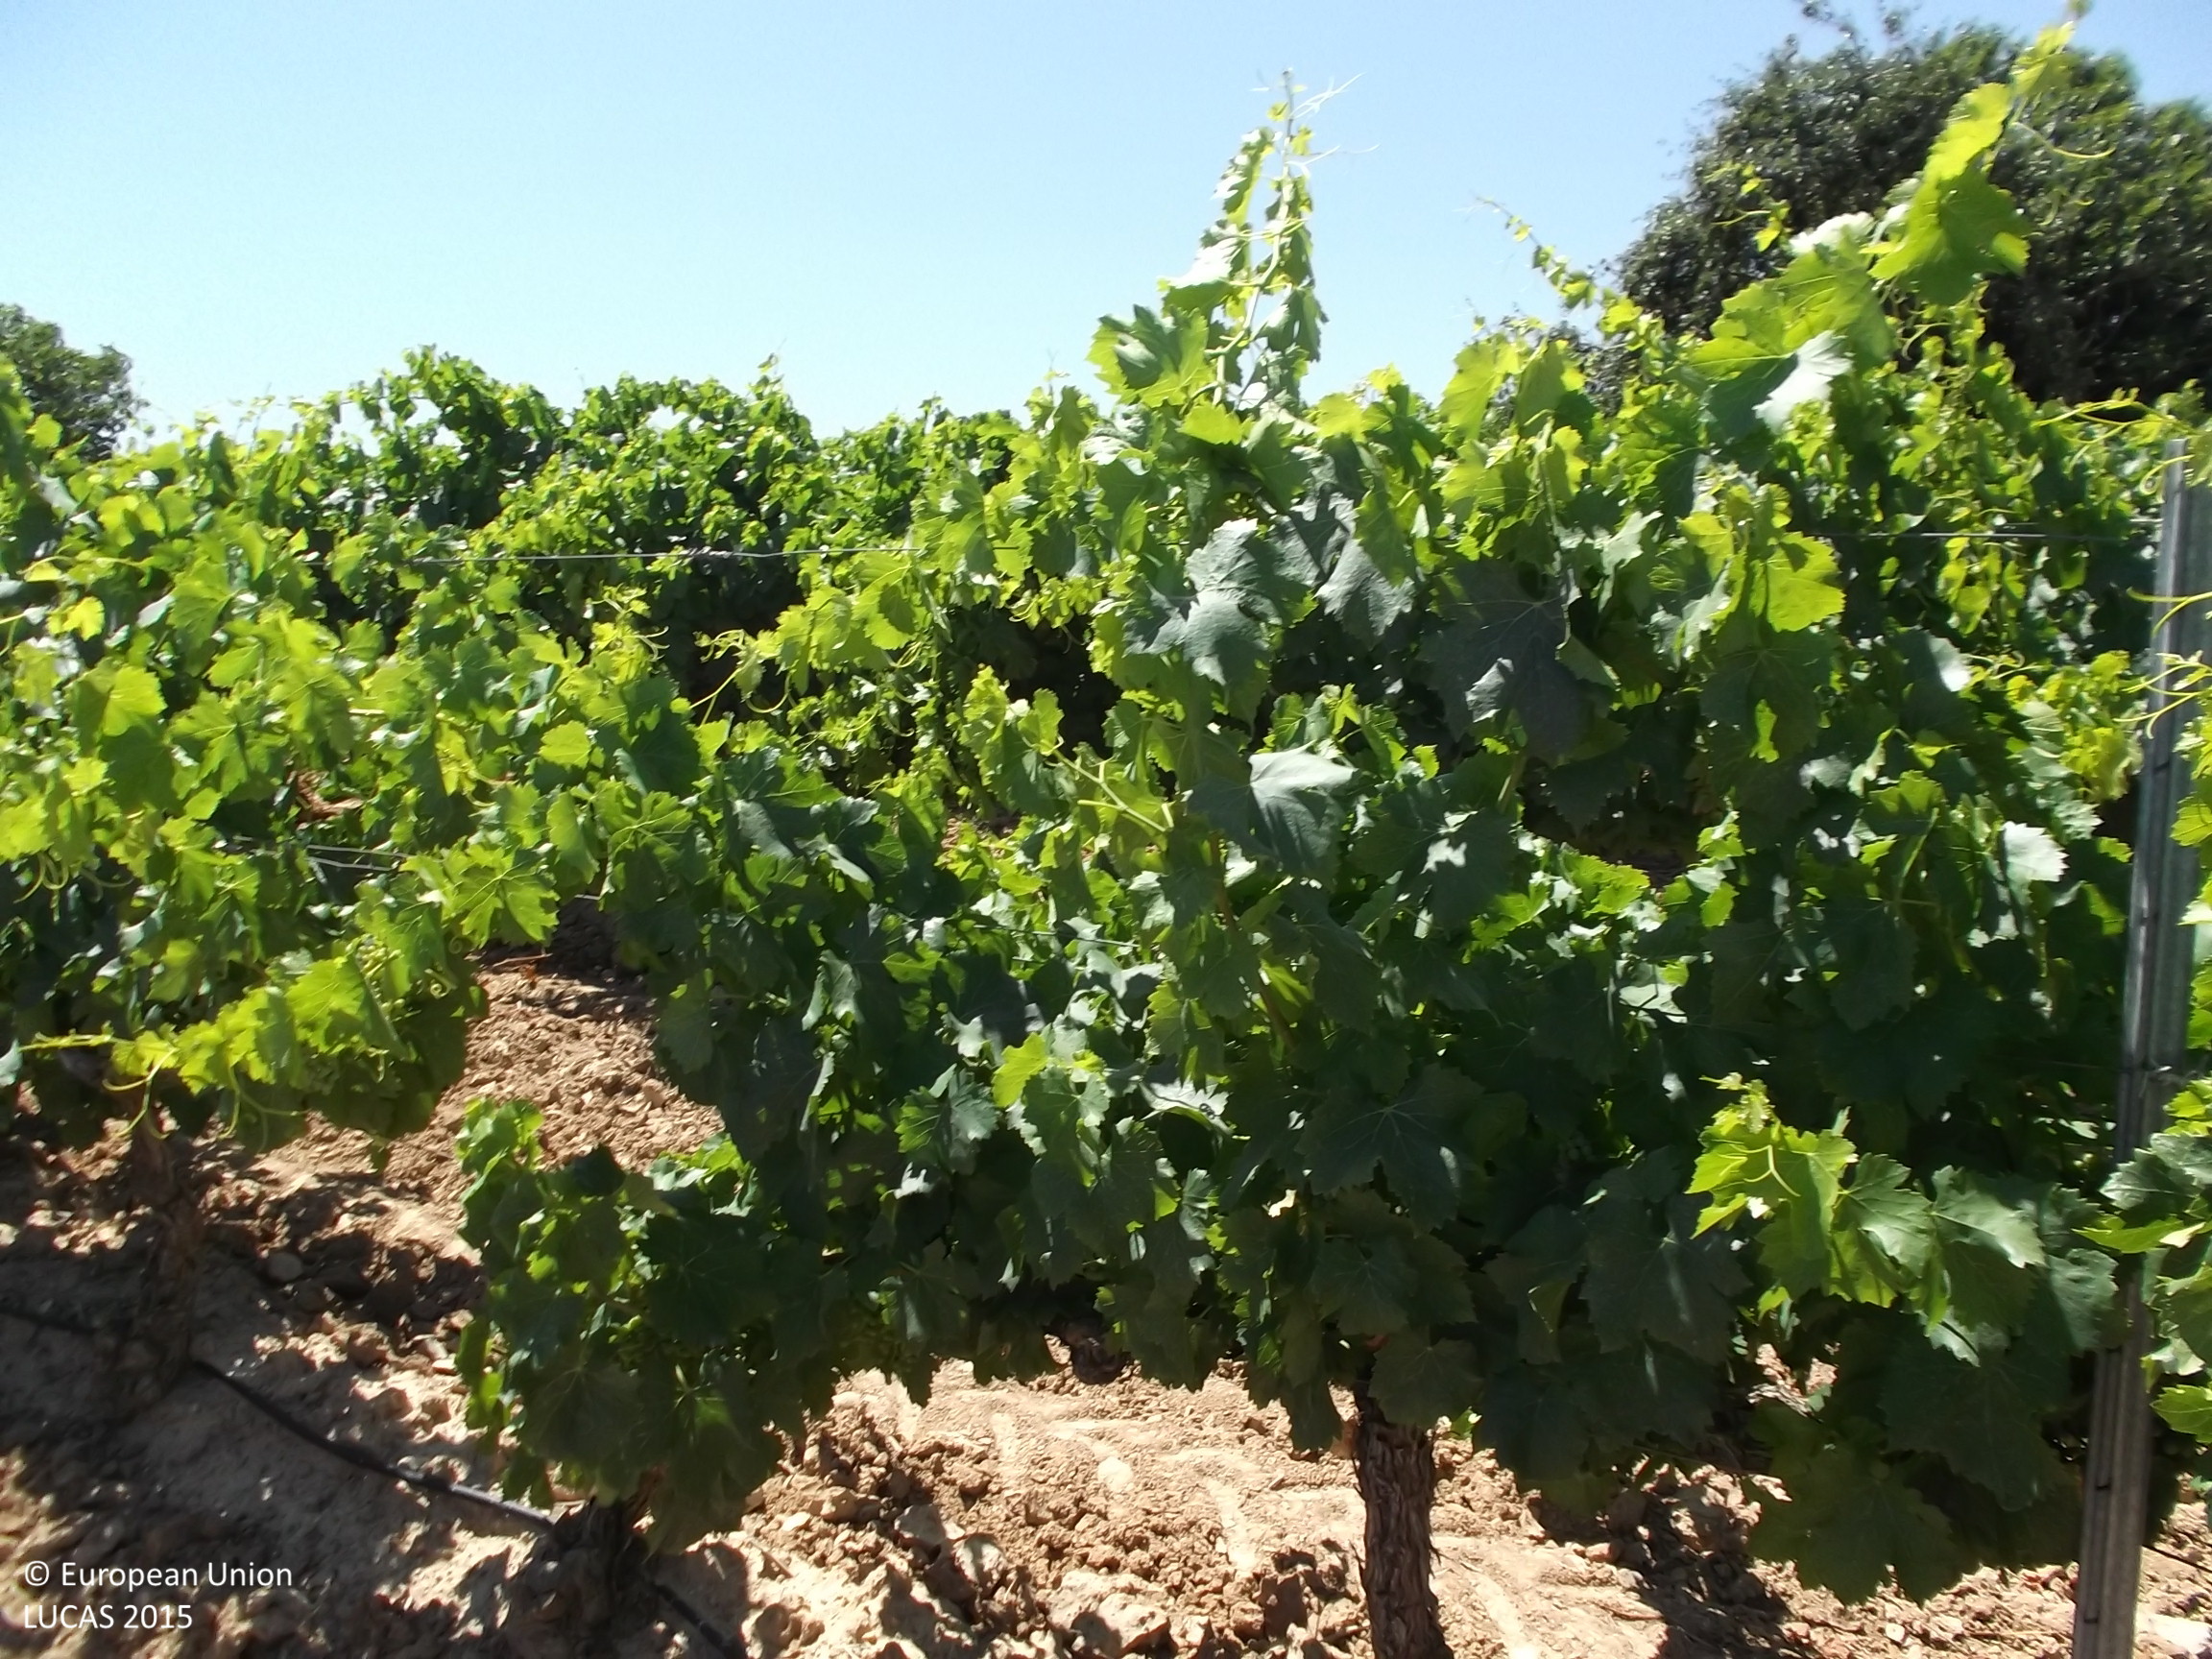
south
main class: Cropland
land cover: Vineyards
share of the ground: 25 - 50 %
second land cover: Other bare soil
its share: > 75 %
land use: Agriculture (excluding fallow land and kitchen gardens)
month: July
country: ES
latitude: 42.2600
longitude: -2.0515
